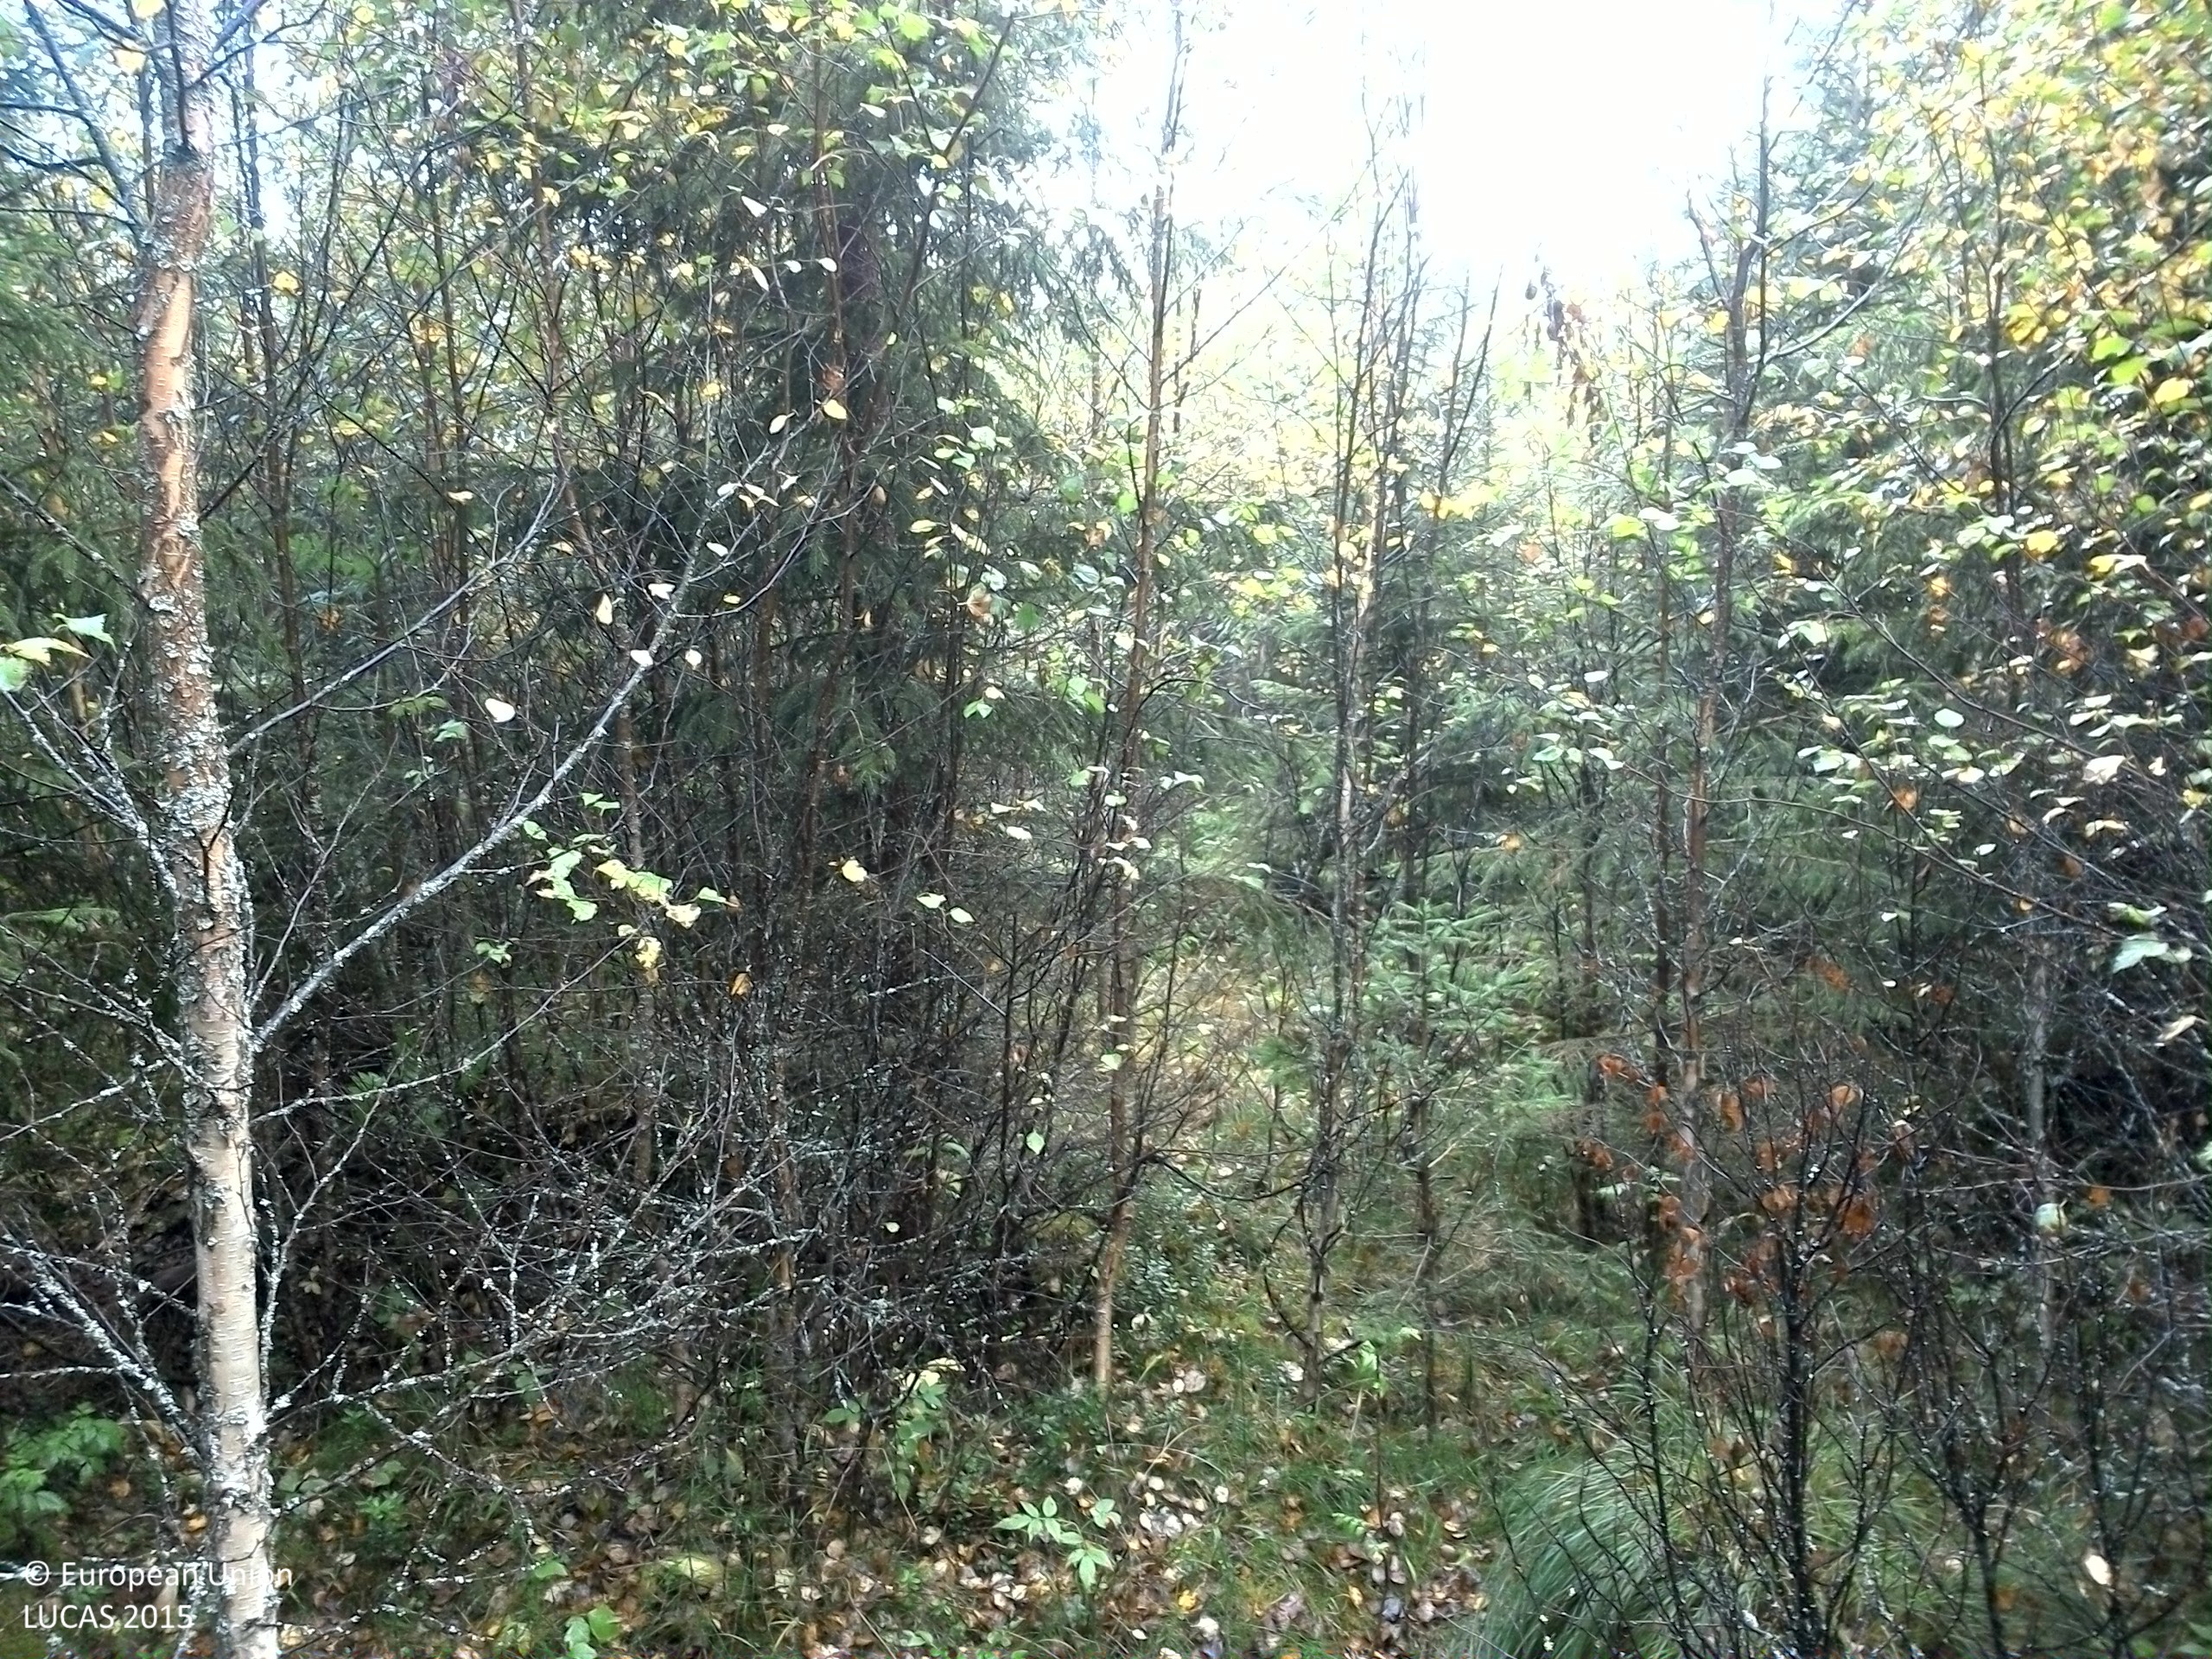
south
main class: Woodland
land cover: Spruce dominated mixed woodland
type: boreal forest
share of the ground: 50 - 75 %
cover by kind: coniferous forest trees 45 %, broadleaved forest trees 25 %, shrubs 15 %, herbaceous plants 15 %
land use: Forestry
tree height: < 5 m
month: September
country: SE
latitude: 61.1753
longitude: 14.9871
